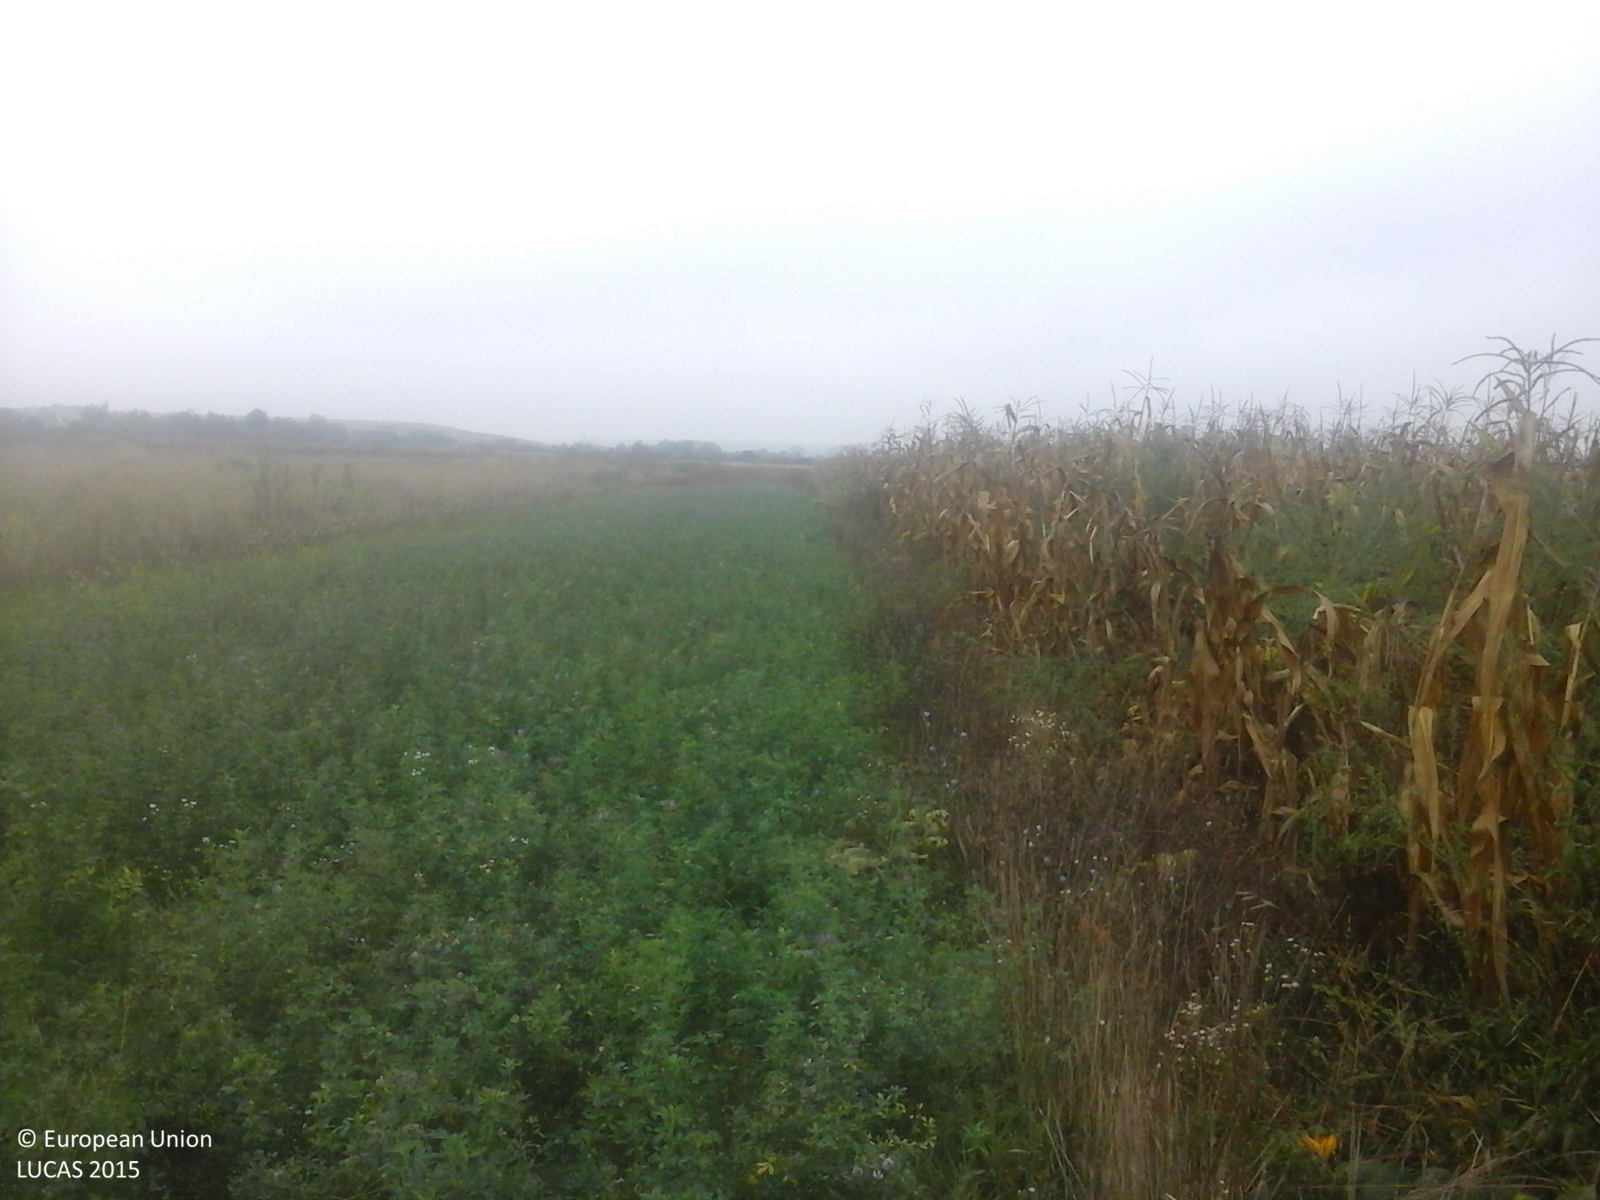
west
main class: Cropland
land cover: Maize
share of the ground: > 75 %
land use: Agriculture (excluding fallow land and kitchen gardens)
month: September
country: RO
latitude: 45.8250
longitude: 22.1028
